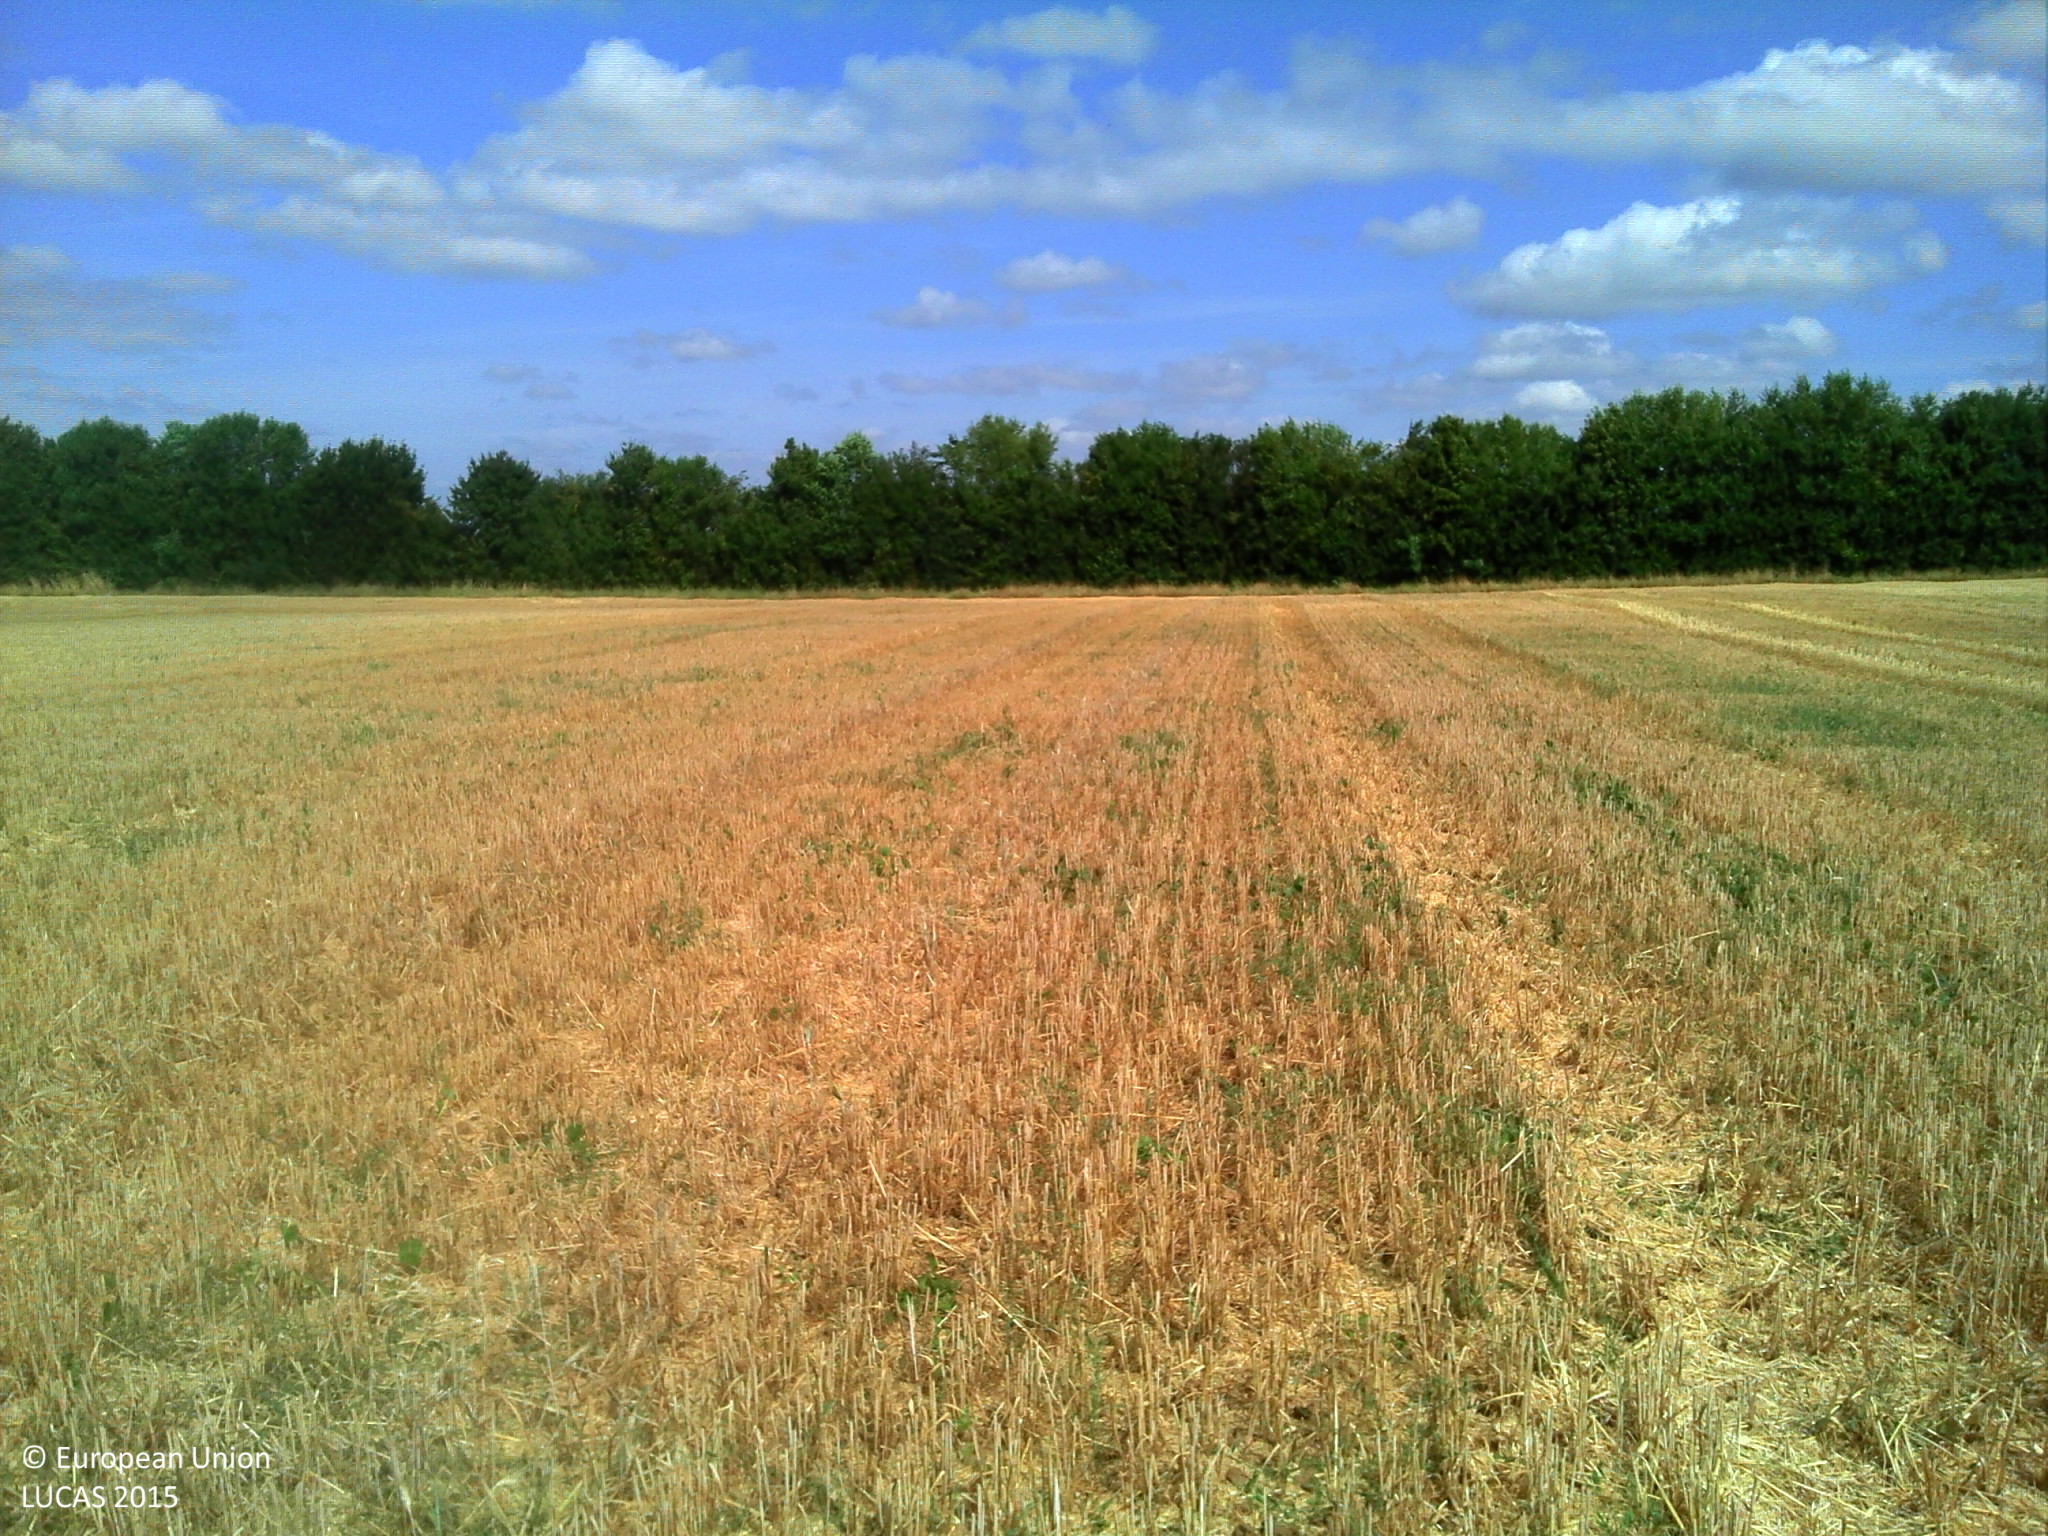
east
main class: Cropland
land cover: Durum wheat
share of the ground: > 75 %
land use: Agriculture (excluding fallow land and kitchen gardens)
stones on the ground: 10 - 25 %
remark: Harvested field
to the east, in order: Durum wheat; Grass margins; Managed hedges; Grass margins; Tracks; Grass margins; Maize; Sunflower
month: July
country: FR
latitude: 45.4955
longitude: -0.6054
